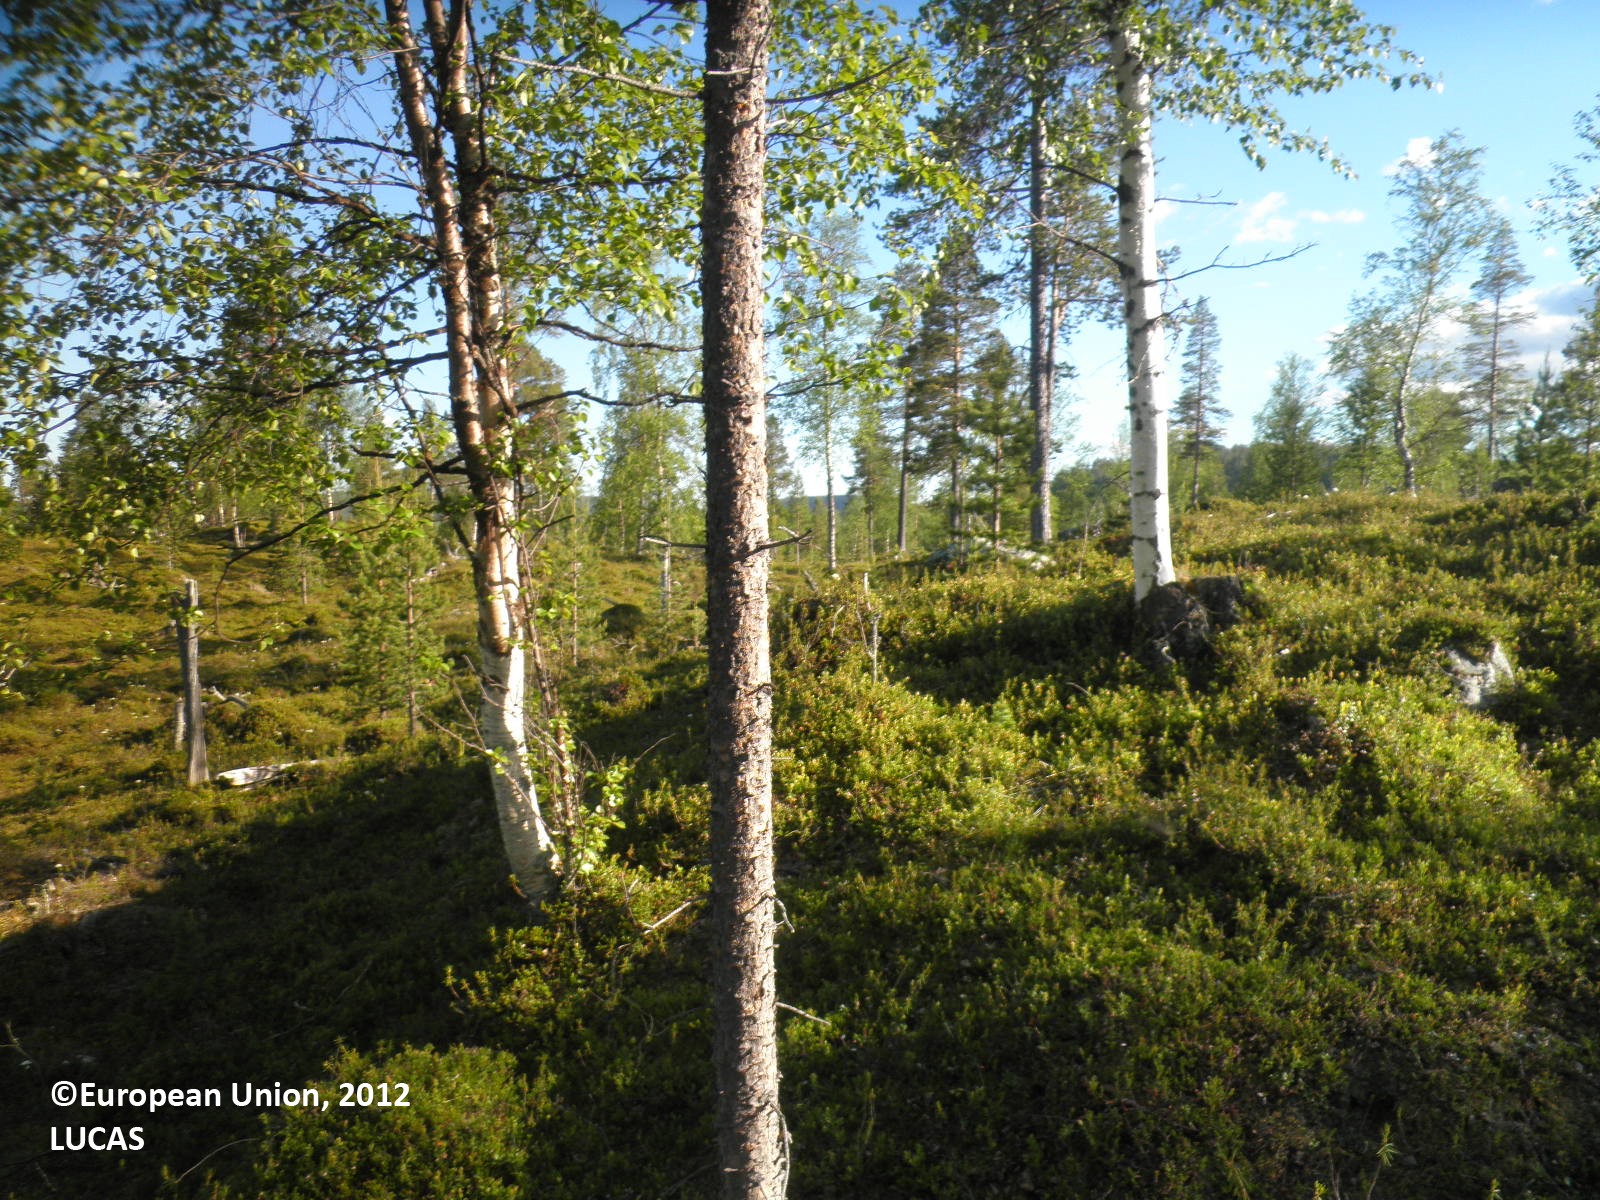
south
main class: Woodland
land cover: Pine dominated mixed woodland
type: boreal forest
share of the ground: 25 - 50 %
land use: Forestry
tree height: > 5 m
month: July
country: FI
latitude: 68.8534
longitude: 27.2295
